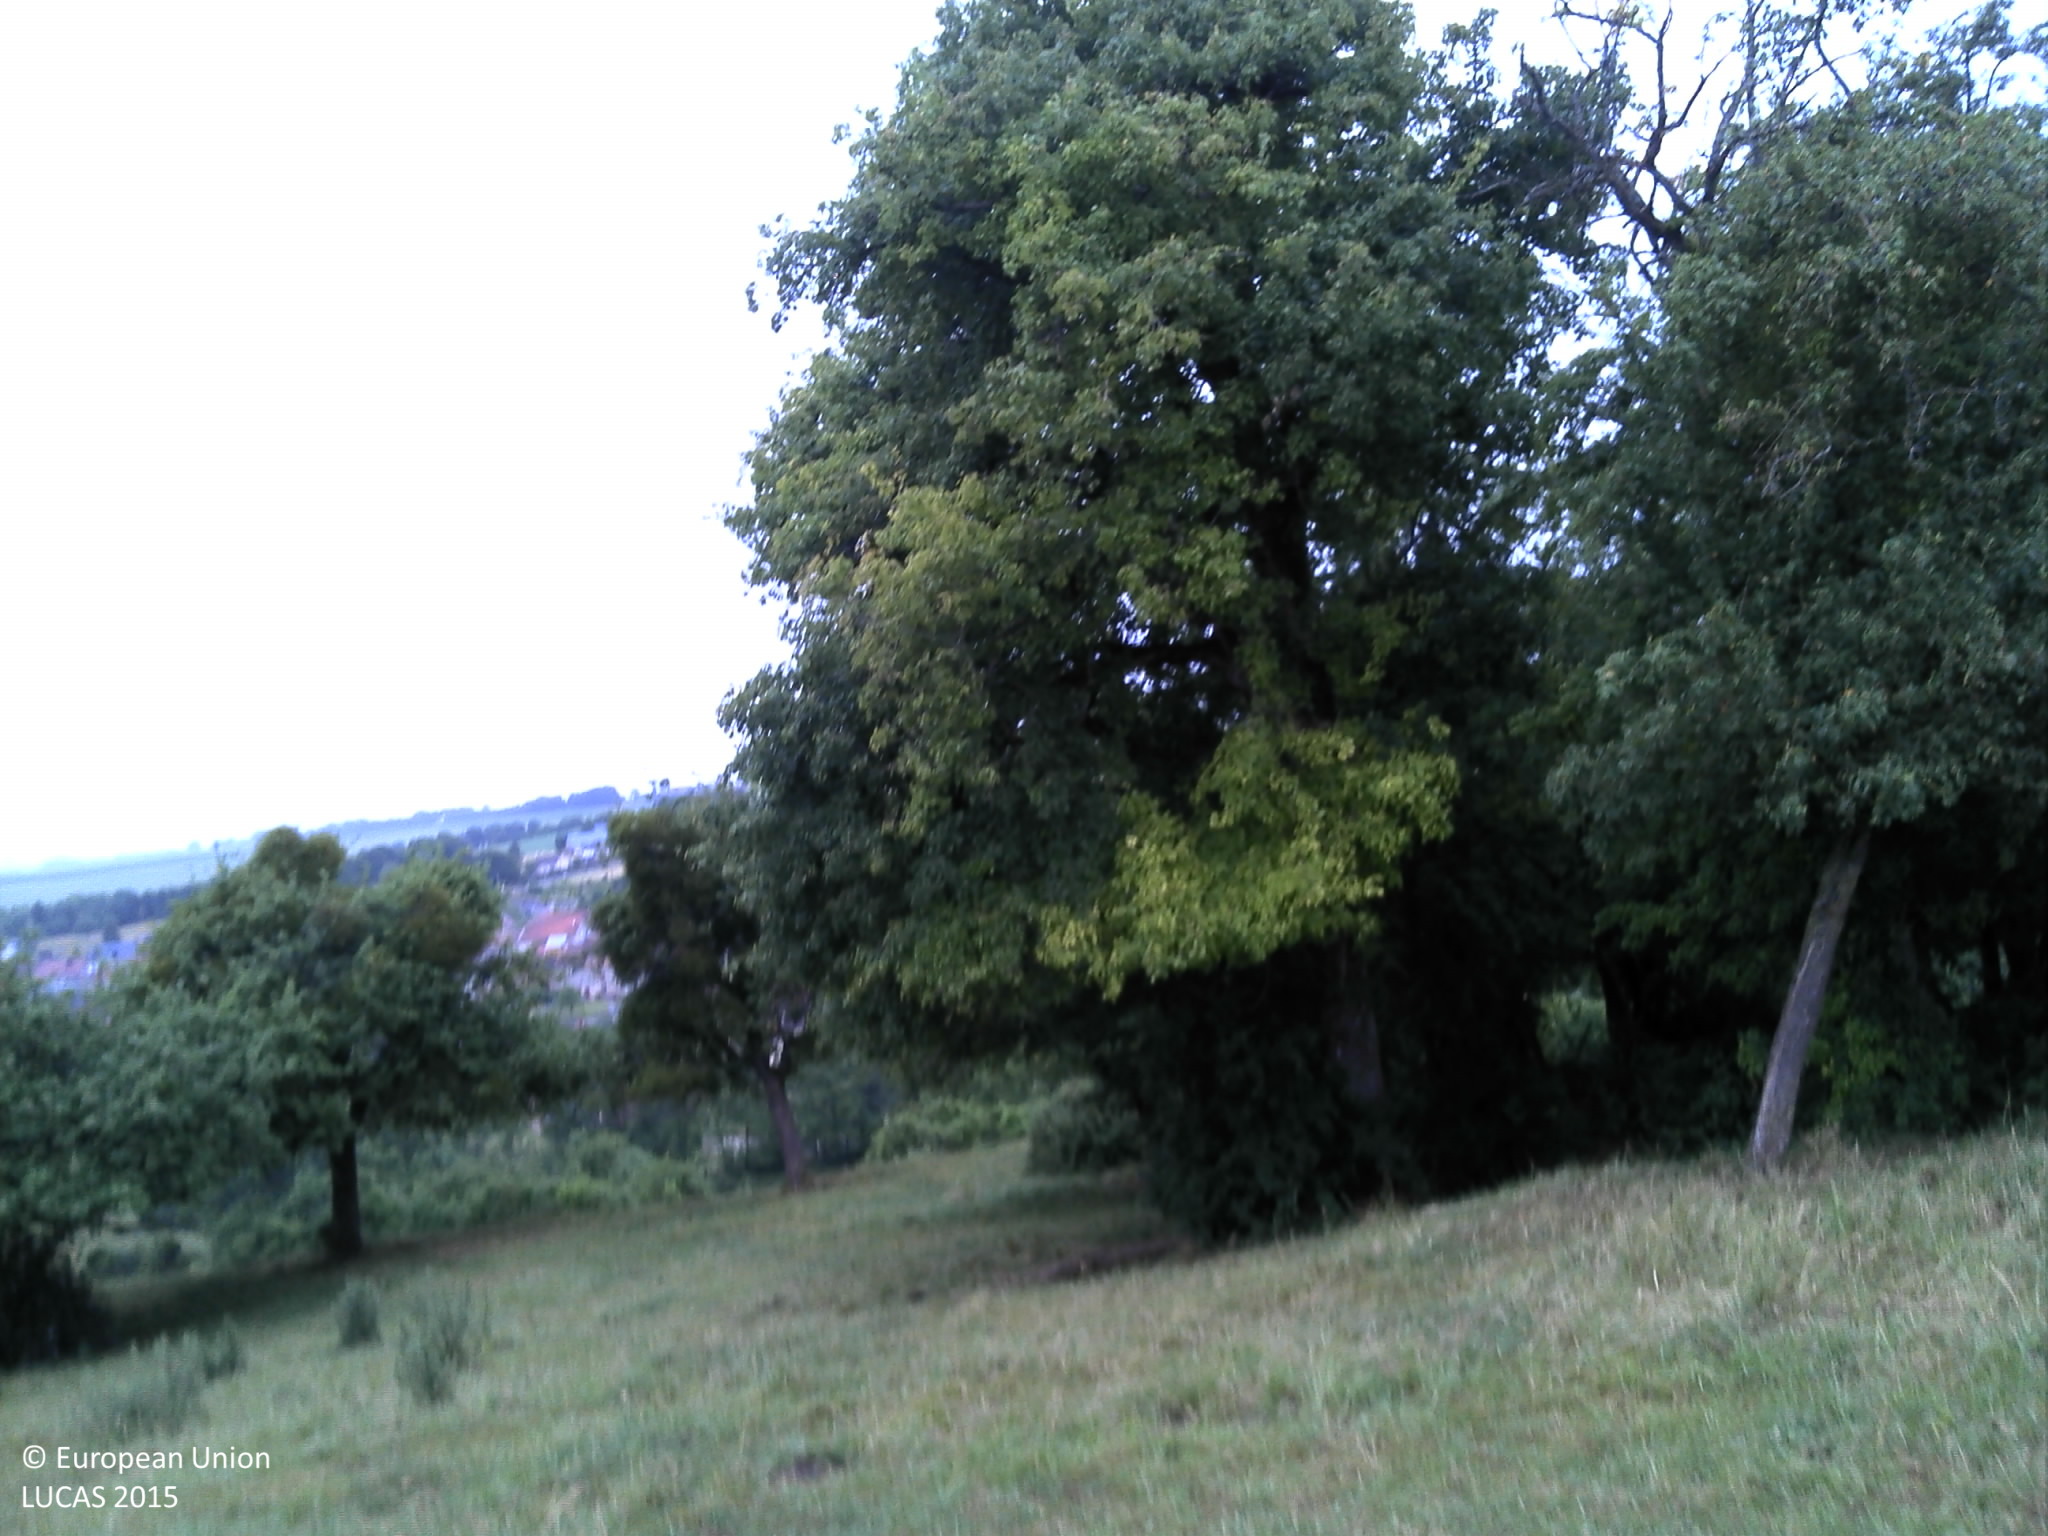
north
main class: Cropland
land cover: Maize
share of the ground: > 75 %
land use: Agriculture (excluding fallow land and kitchen gardens)
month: June
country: FR
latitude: 49.5369
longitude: 5.0645
